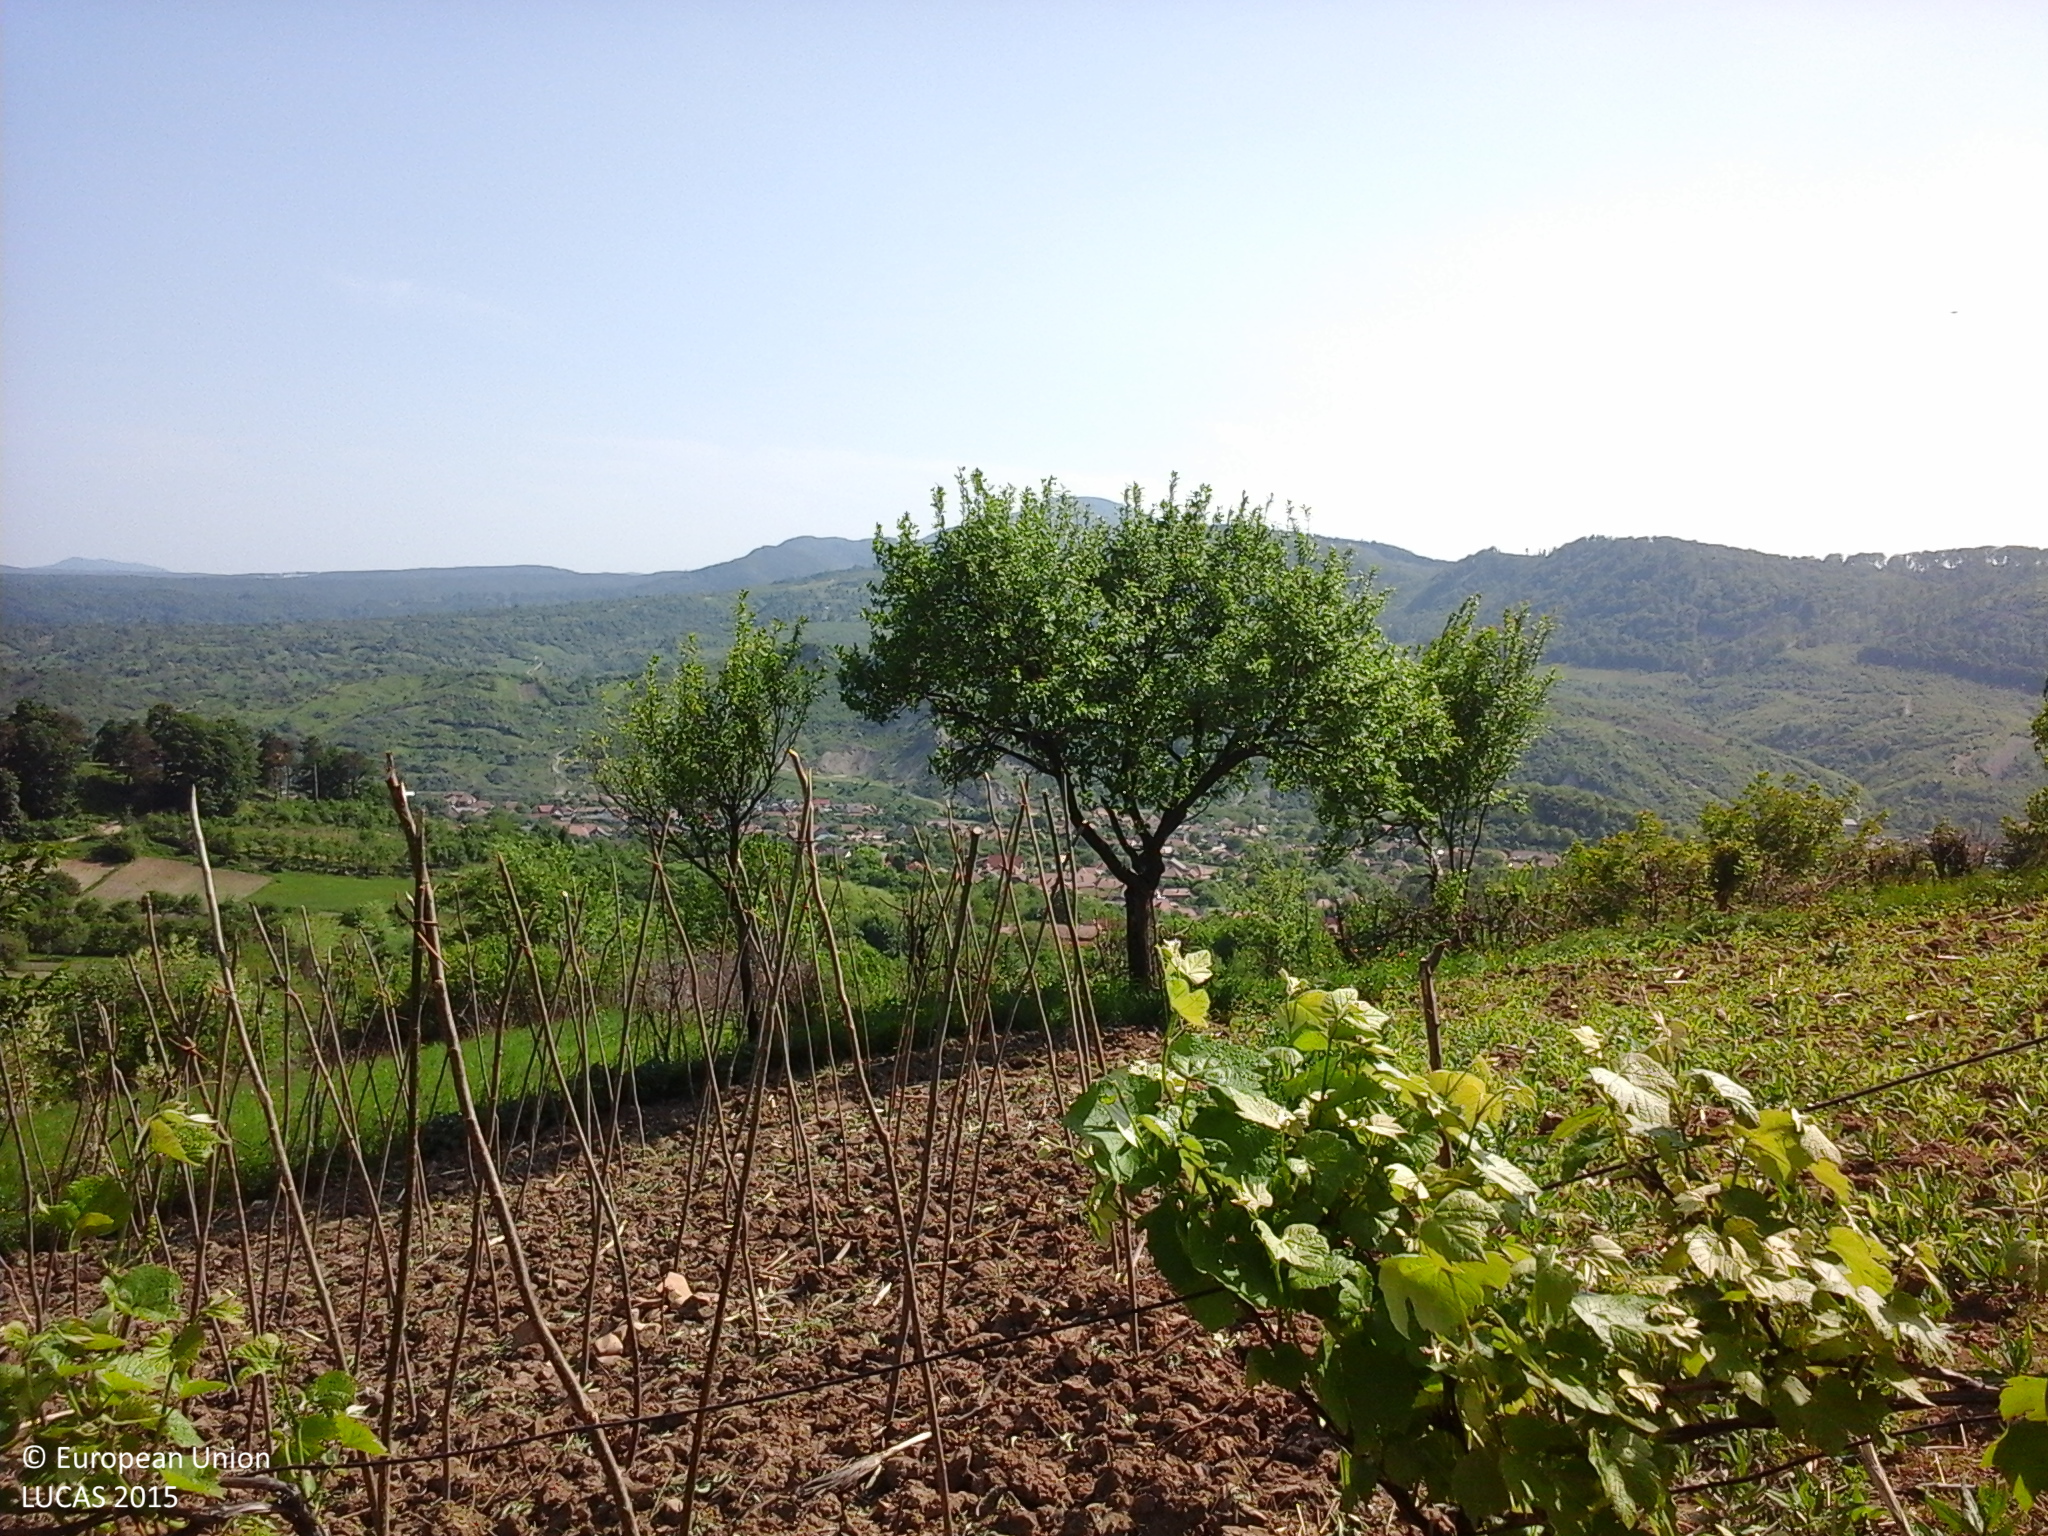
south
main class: Cropland
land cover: Other leguminous and mixtures for fodder
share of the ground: > 75 %
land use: Agriculture (excluding fallow land and kitchen gardens)
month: May
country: RO
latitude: 46.2167
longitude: 26.6109
